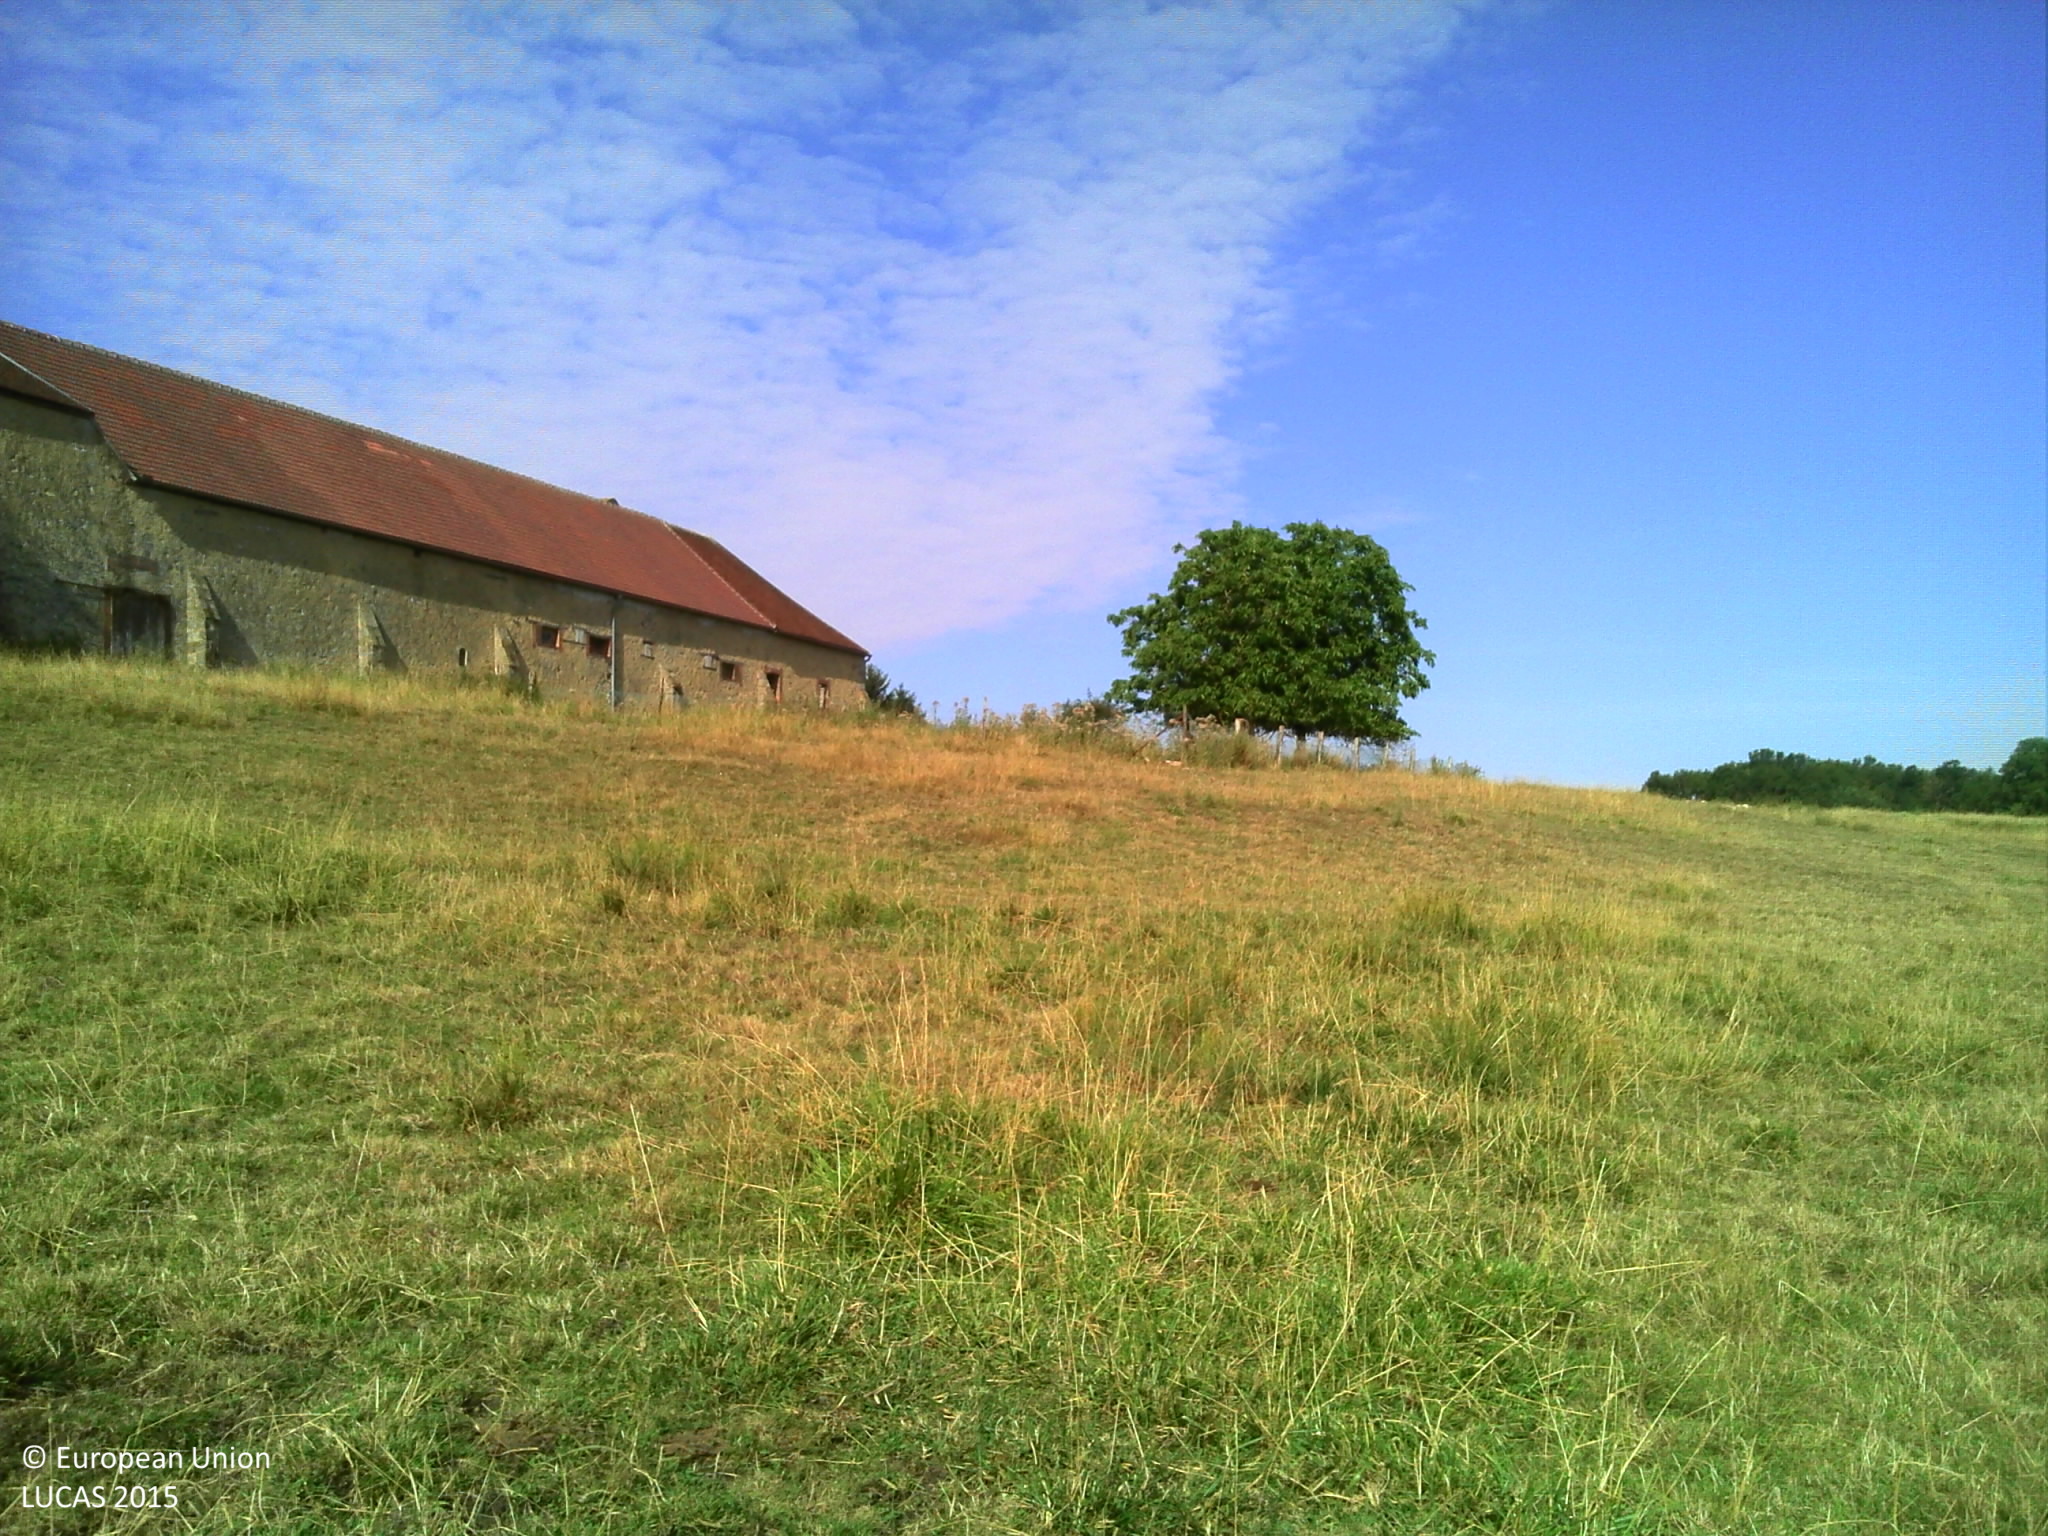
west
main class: Grassland
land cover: Grassland without tree/shrub cover
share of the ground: > 75 %
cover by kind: herbaceous plants 85 %, unconsolidated bare surface 10 %
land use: Agriculture (excluding fallow land and kitchen gardens)
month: August
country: FR
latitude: 48.7874
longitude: 3.7744
